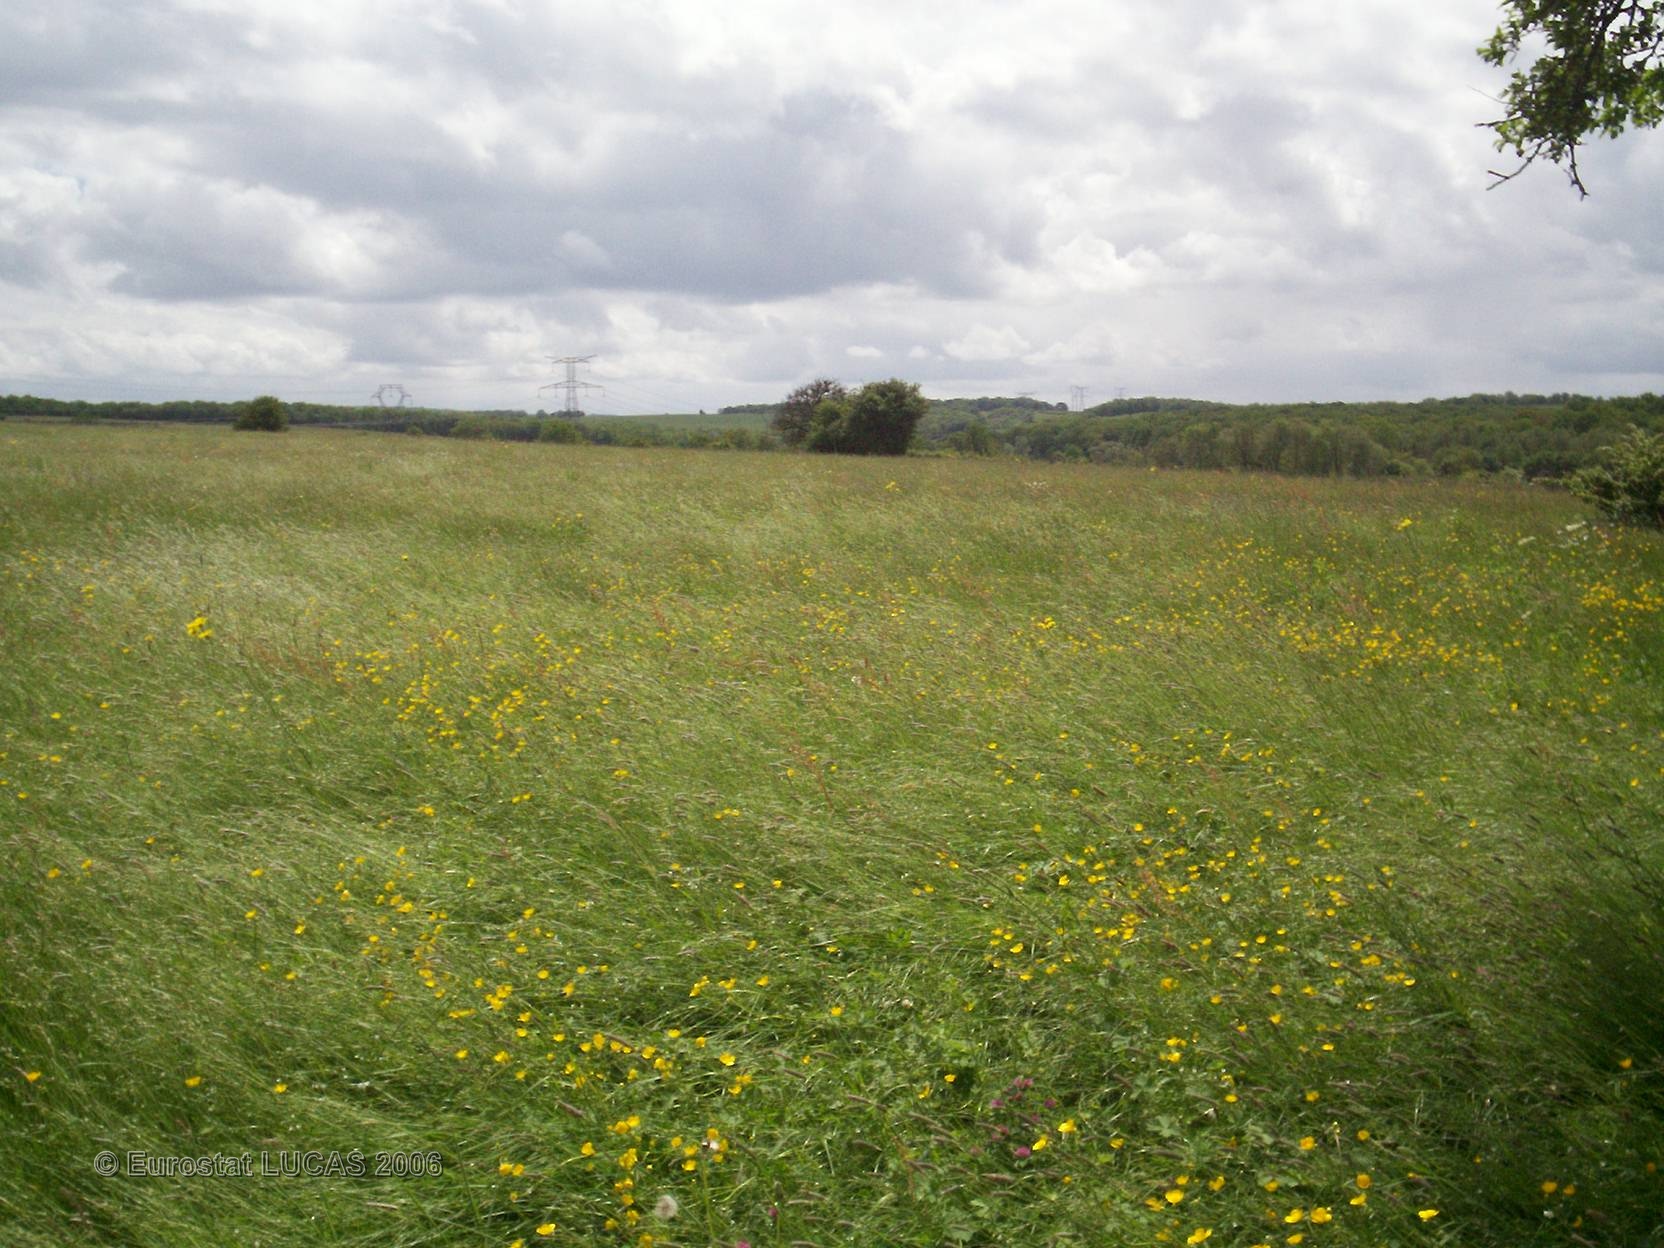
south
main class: Grassland
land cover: Grassland without tree/shrub cover
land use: Agriculture (excluding fallow land and kitchen gardens)
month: May
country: FR
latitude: 47.0638
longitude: 4.6150
